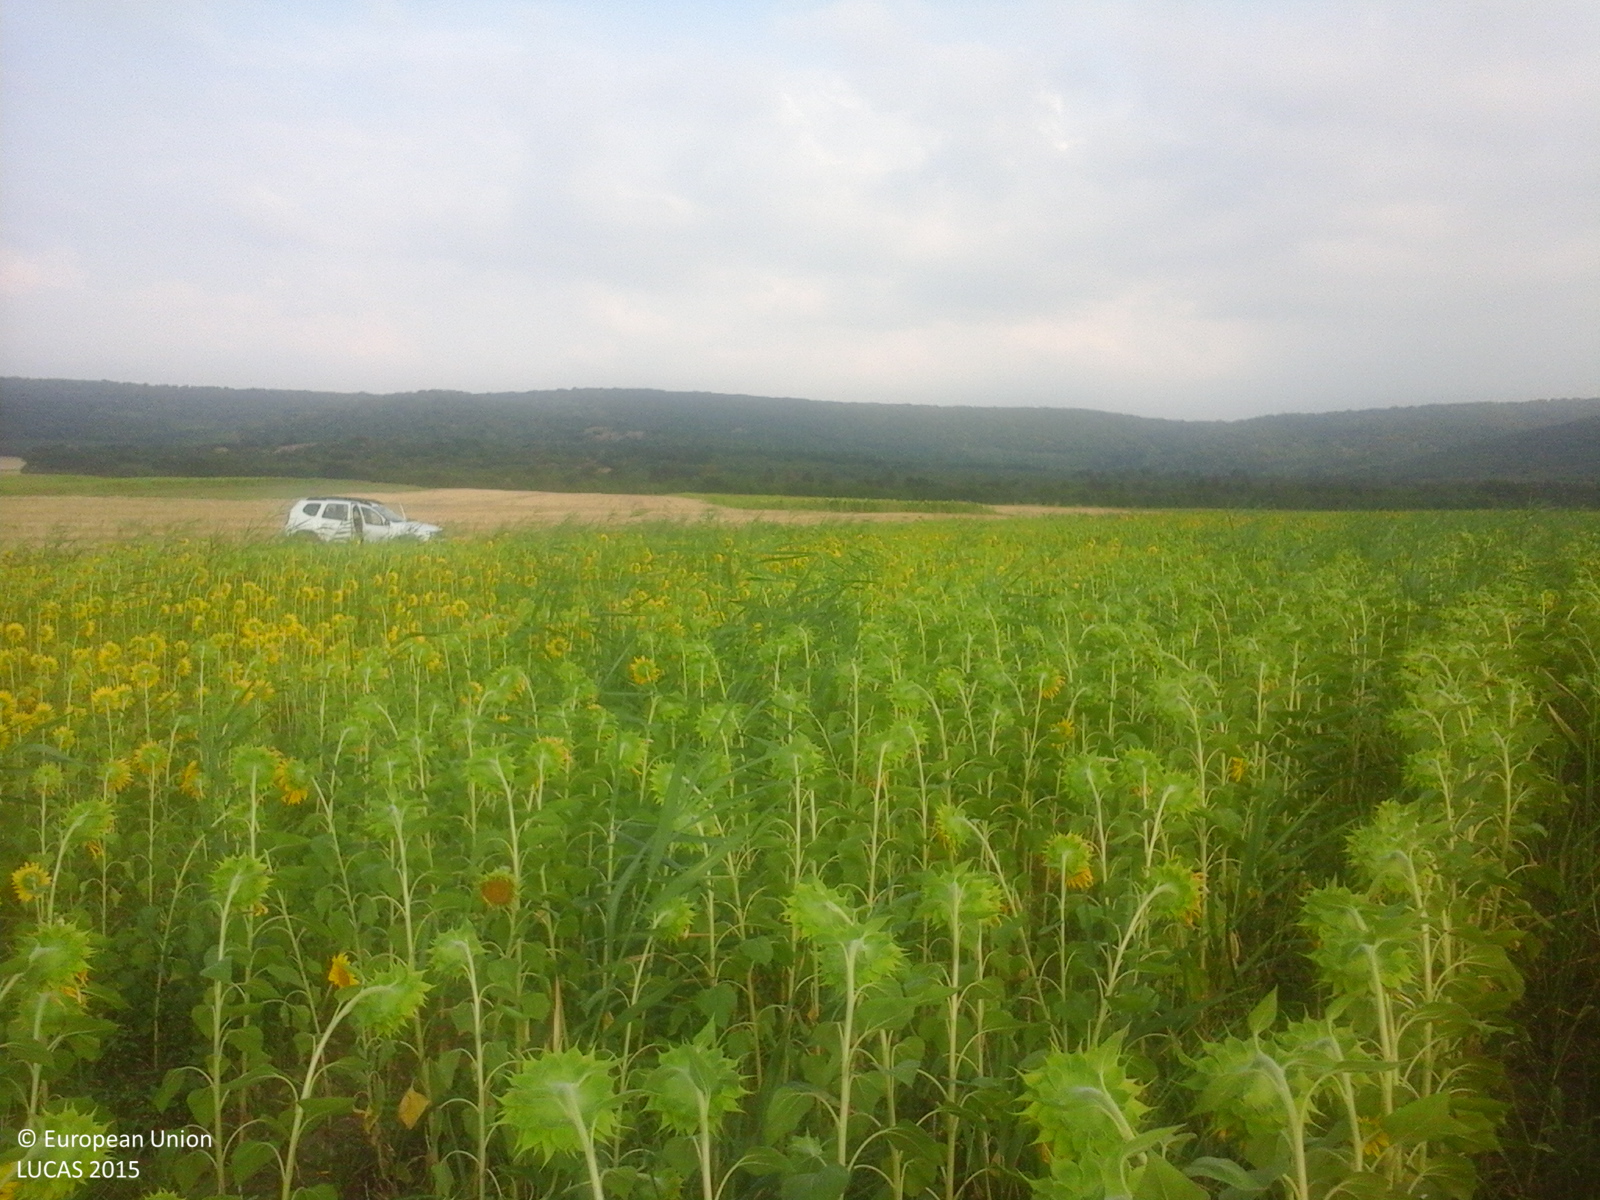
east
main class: Cropland
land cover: Sunflower
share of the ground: > 75 %
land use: Agriculture (excluding fallow land and kitchen gardens)
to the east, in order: Sunflower; Tracks; Common wheat; Lucerne; Common wheat; Lucerne; Sunflower
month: July
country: RO
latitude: 45.0992
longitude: 28.3348
